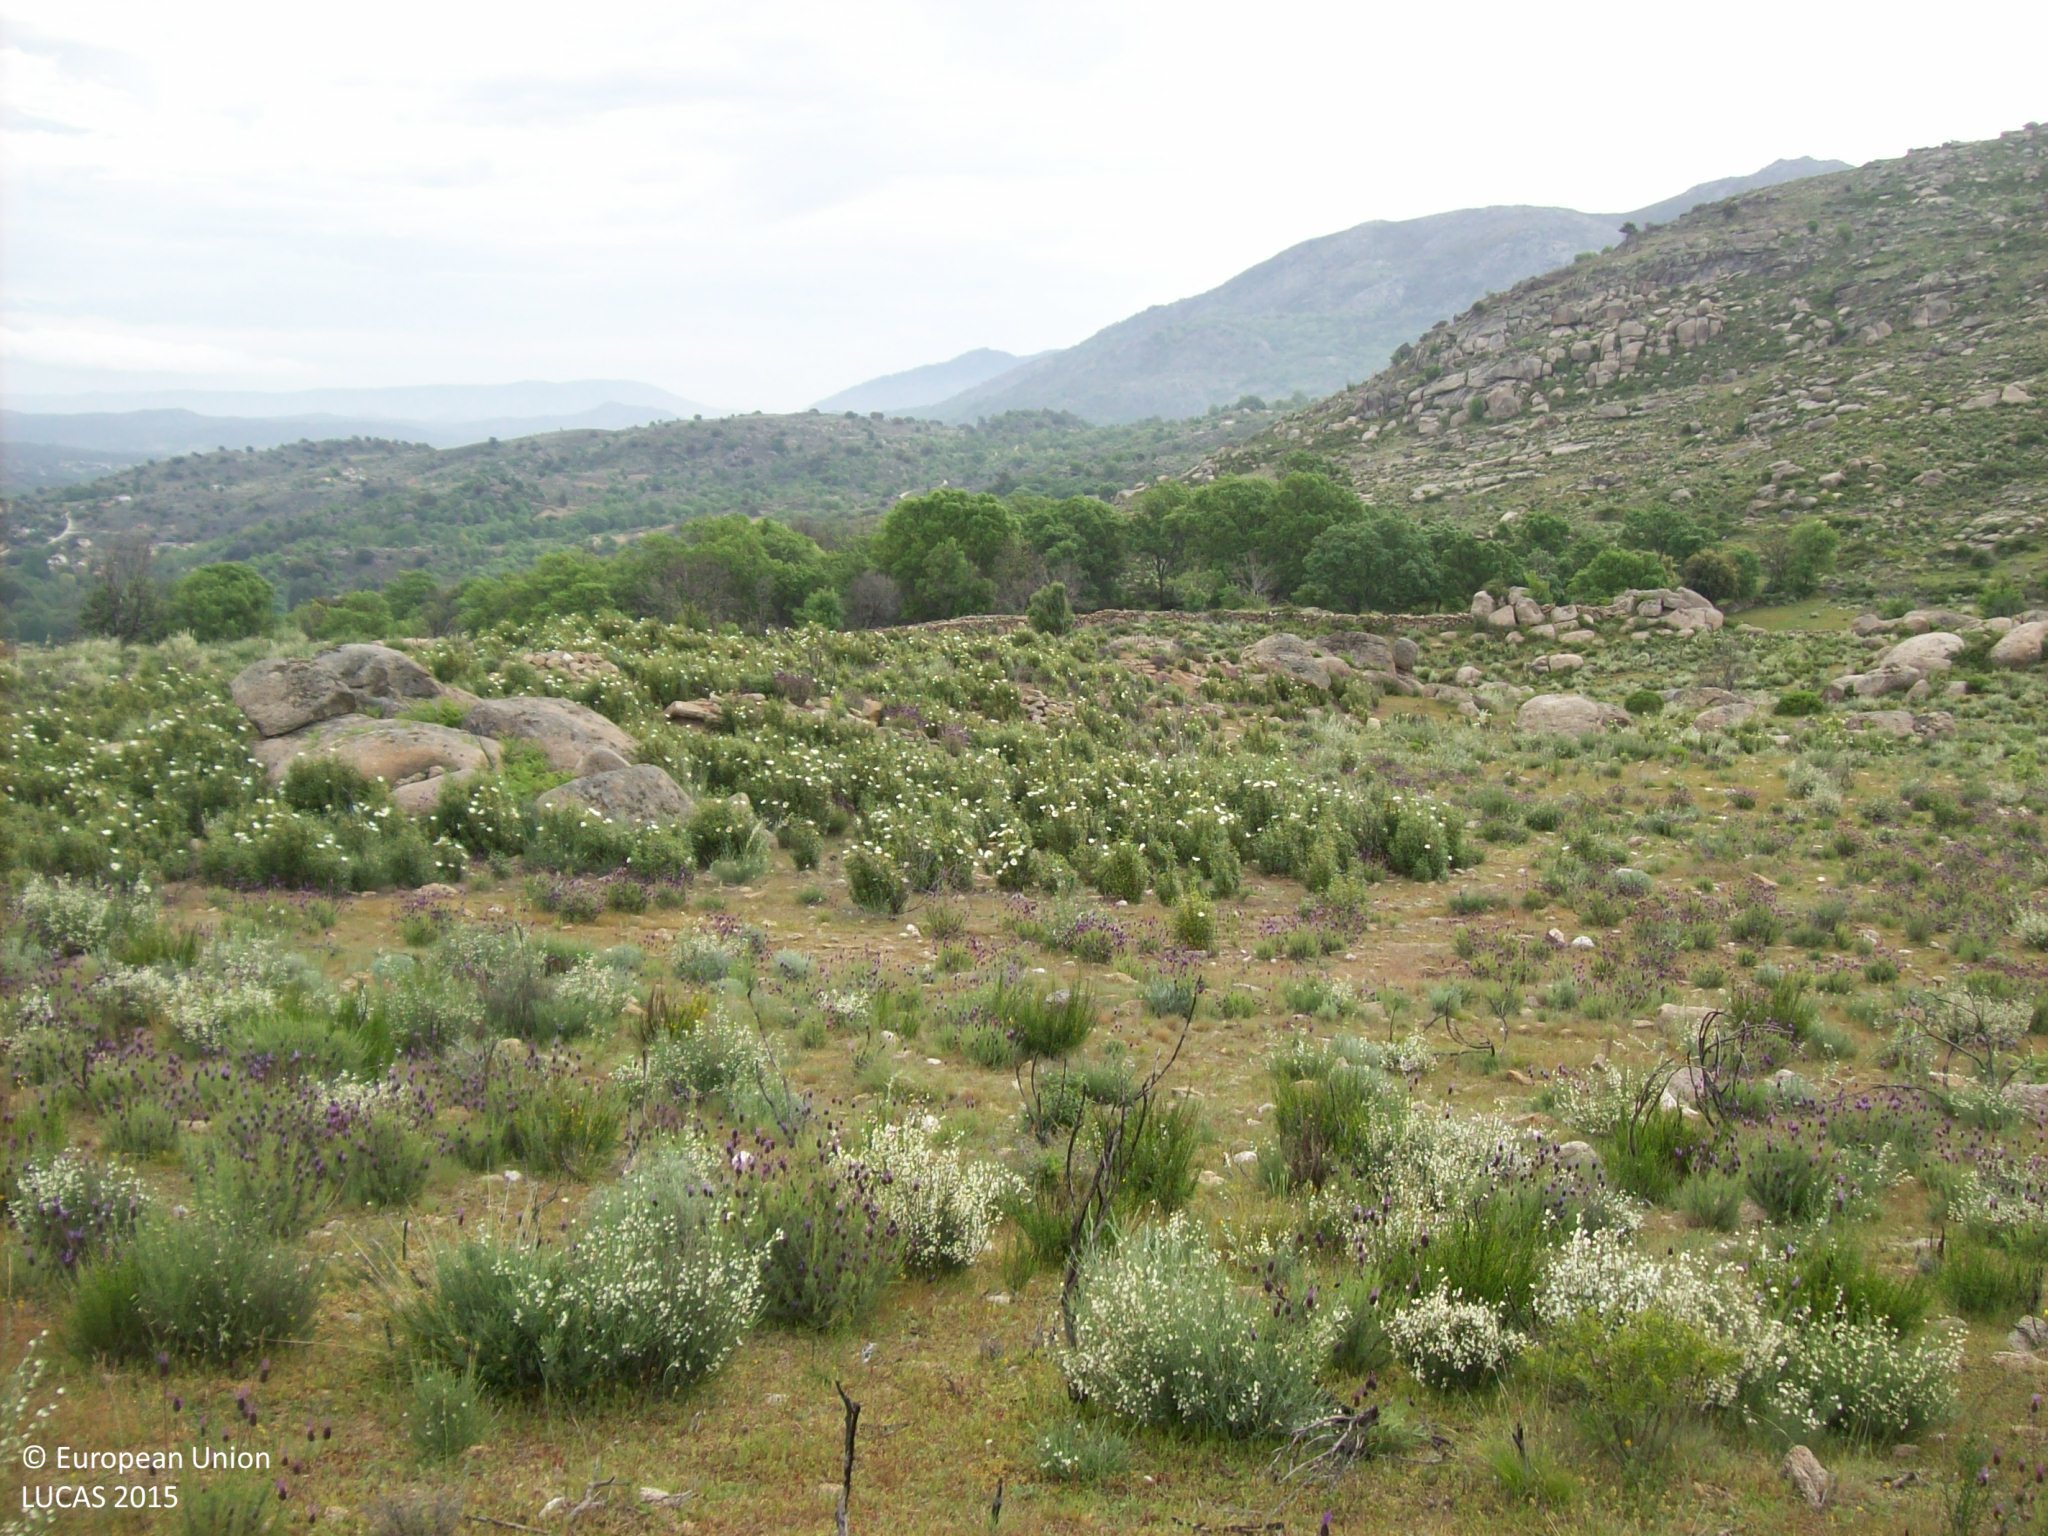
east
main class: Shrubland
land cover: Shrubland without tree cover
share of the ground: 25 - 50 %
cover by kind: herbaceous plants 45 %, shrubs 40 %, consolidated bare surface 10 %
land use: Agriculture (excluding fallow land and kitchen gardens)
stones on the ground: < 10 %
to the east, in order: Shrubland without tree cover; Rock outcrops; Shrubland without tree cover; Dry stone walls; Broadleaved woodland
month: May
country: ES
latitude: 40.3876
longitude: -4.7902
